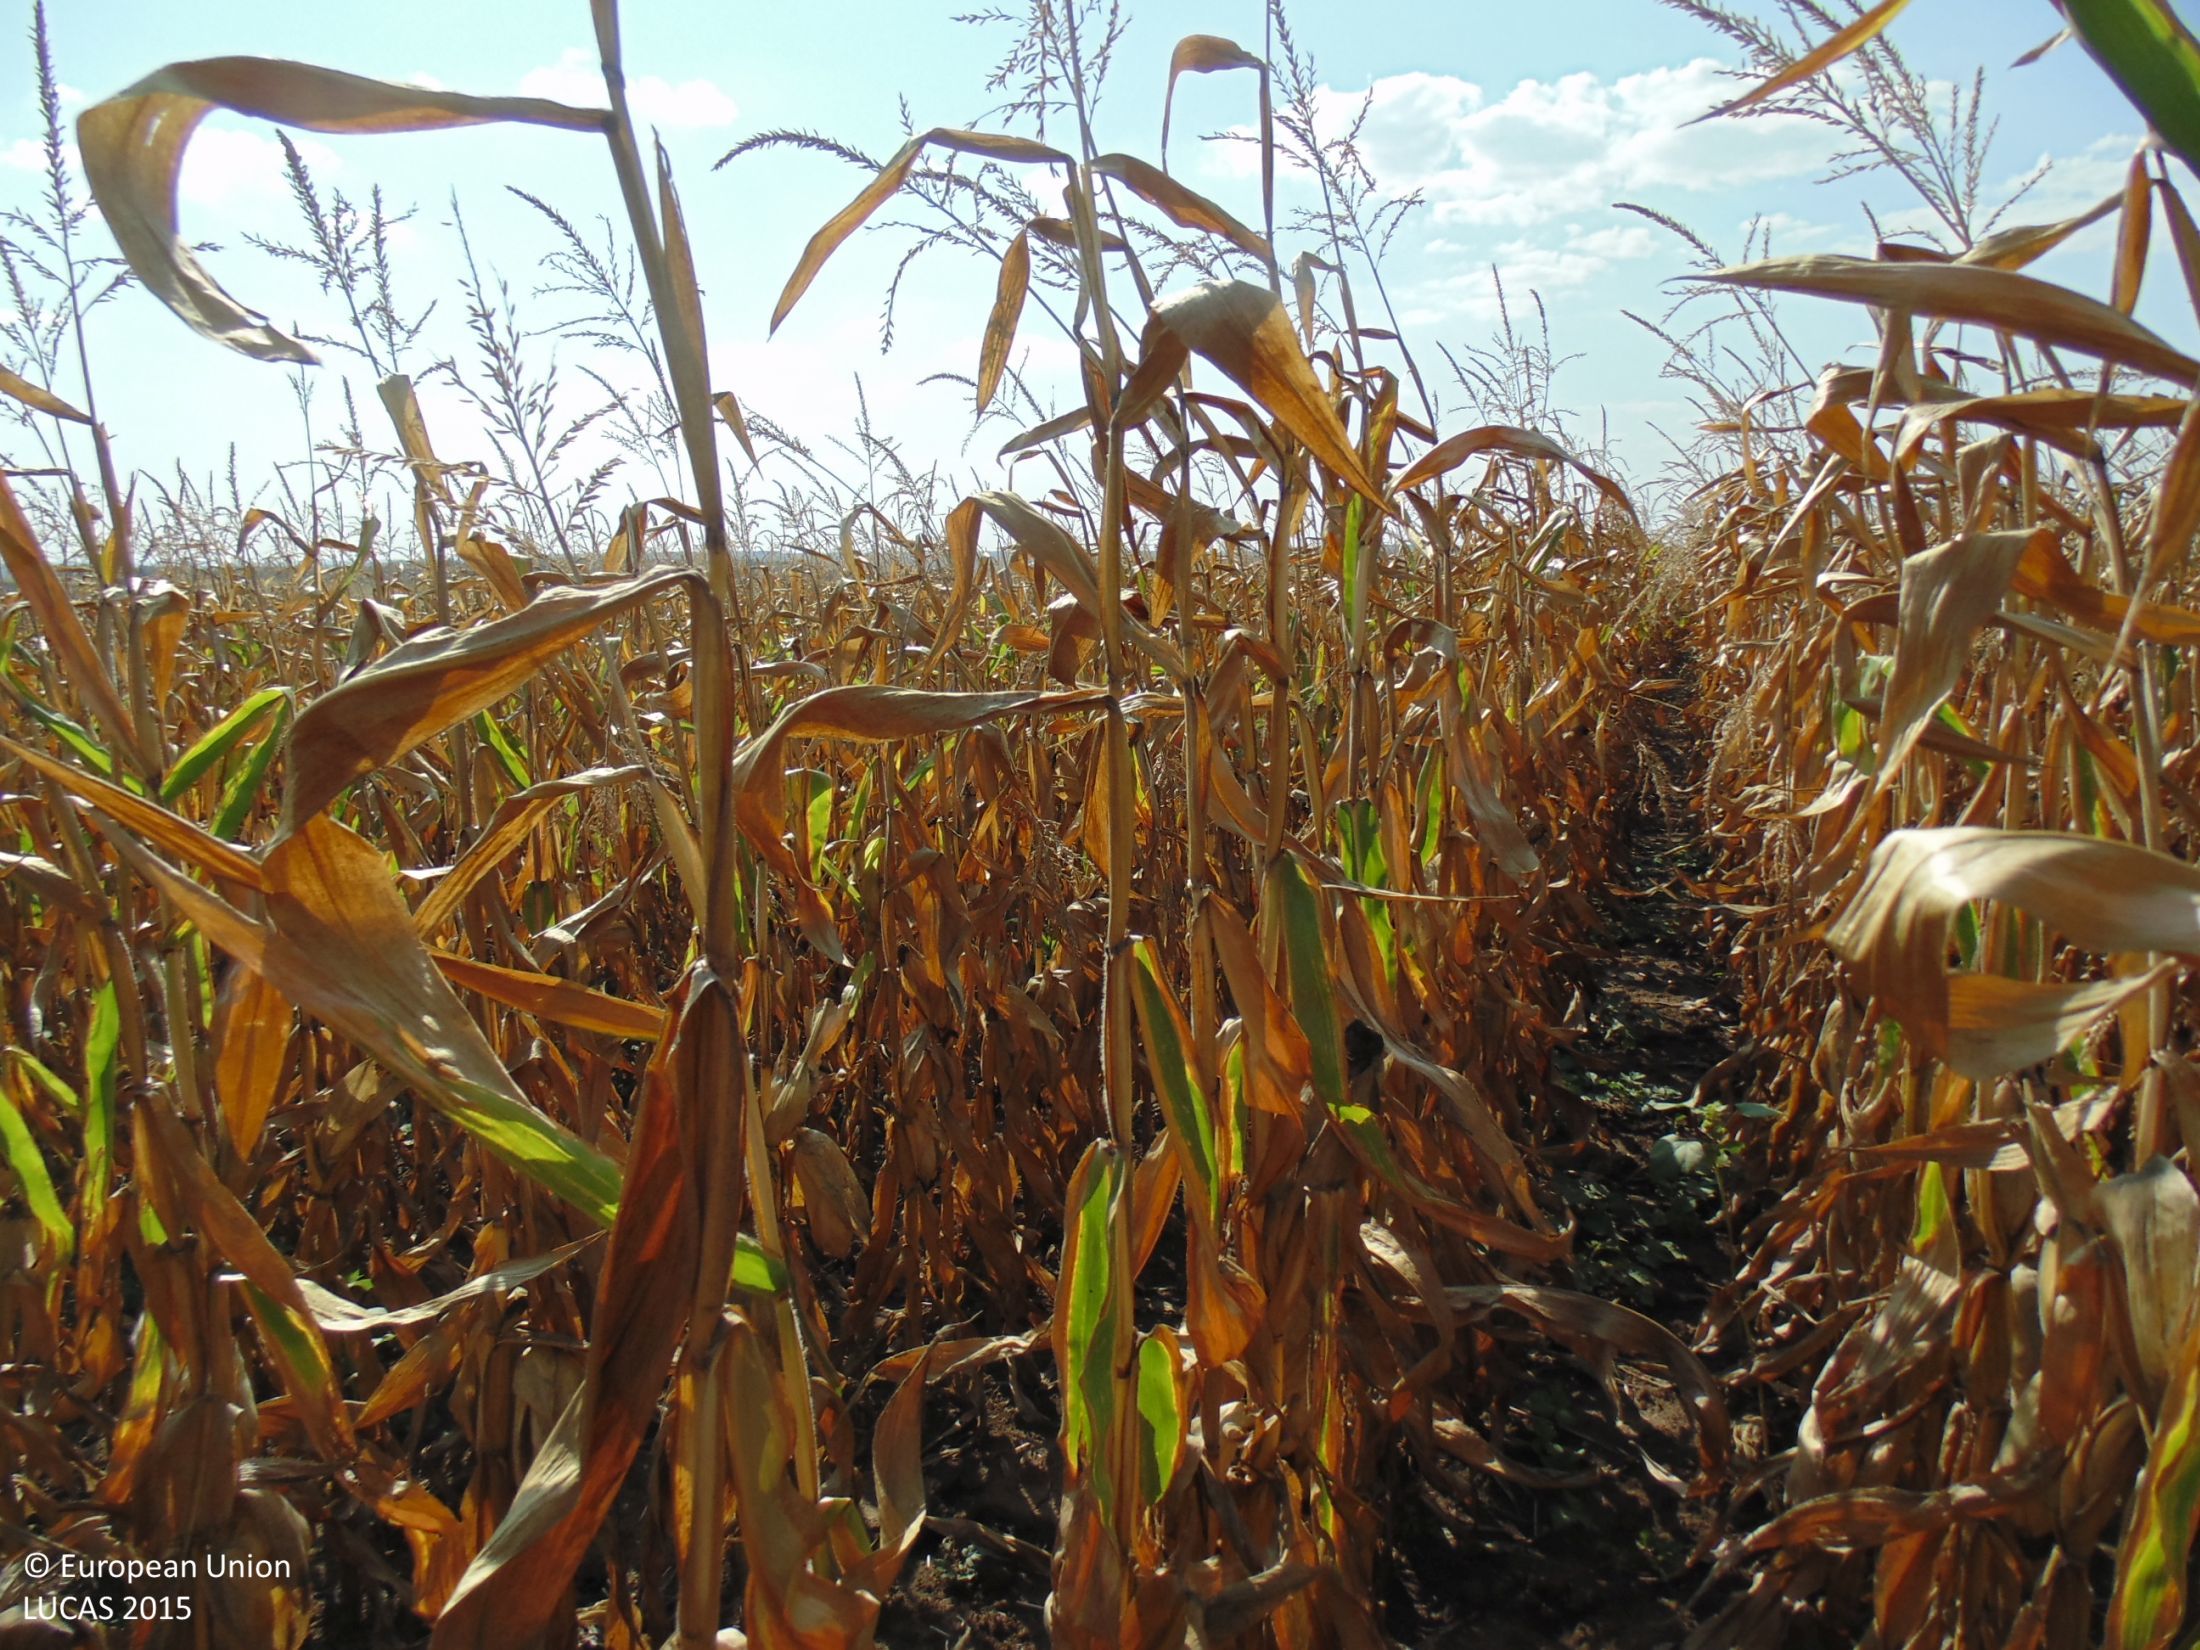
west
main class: Cropland
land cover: Maize
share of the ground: > 75 %
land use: Agriculture (excluding fallow land and kitchen gardens)
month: August
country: BG
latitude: 43.7046
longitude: 27.2389
